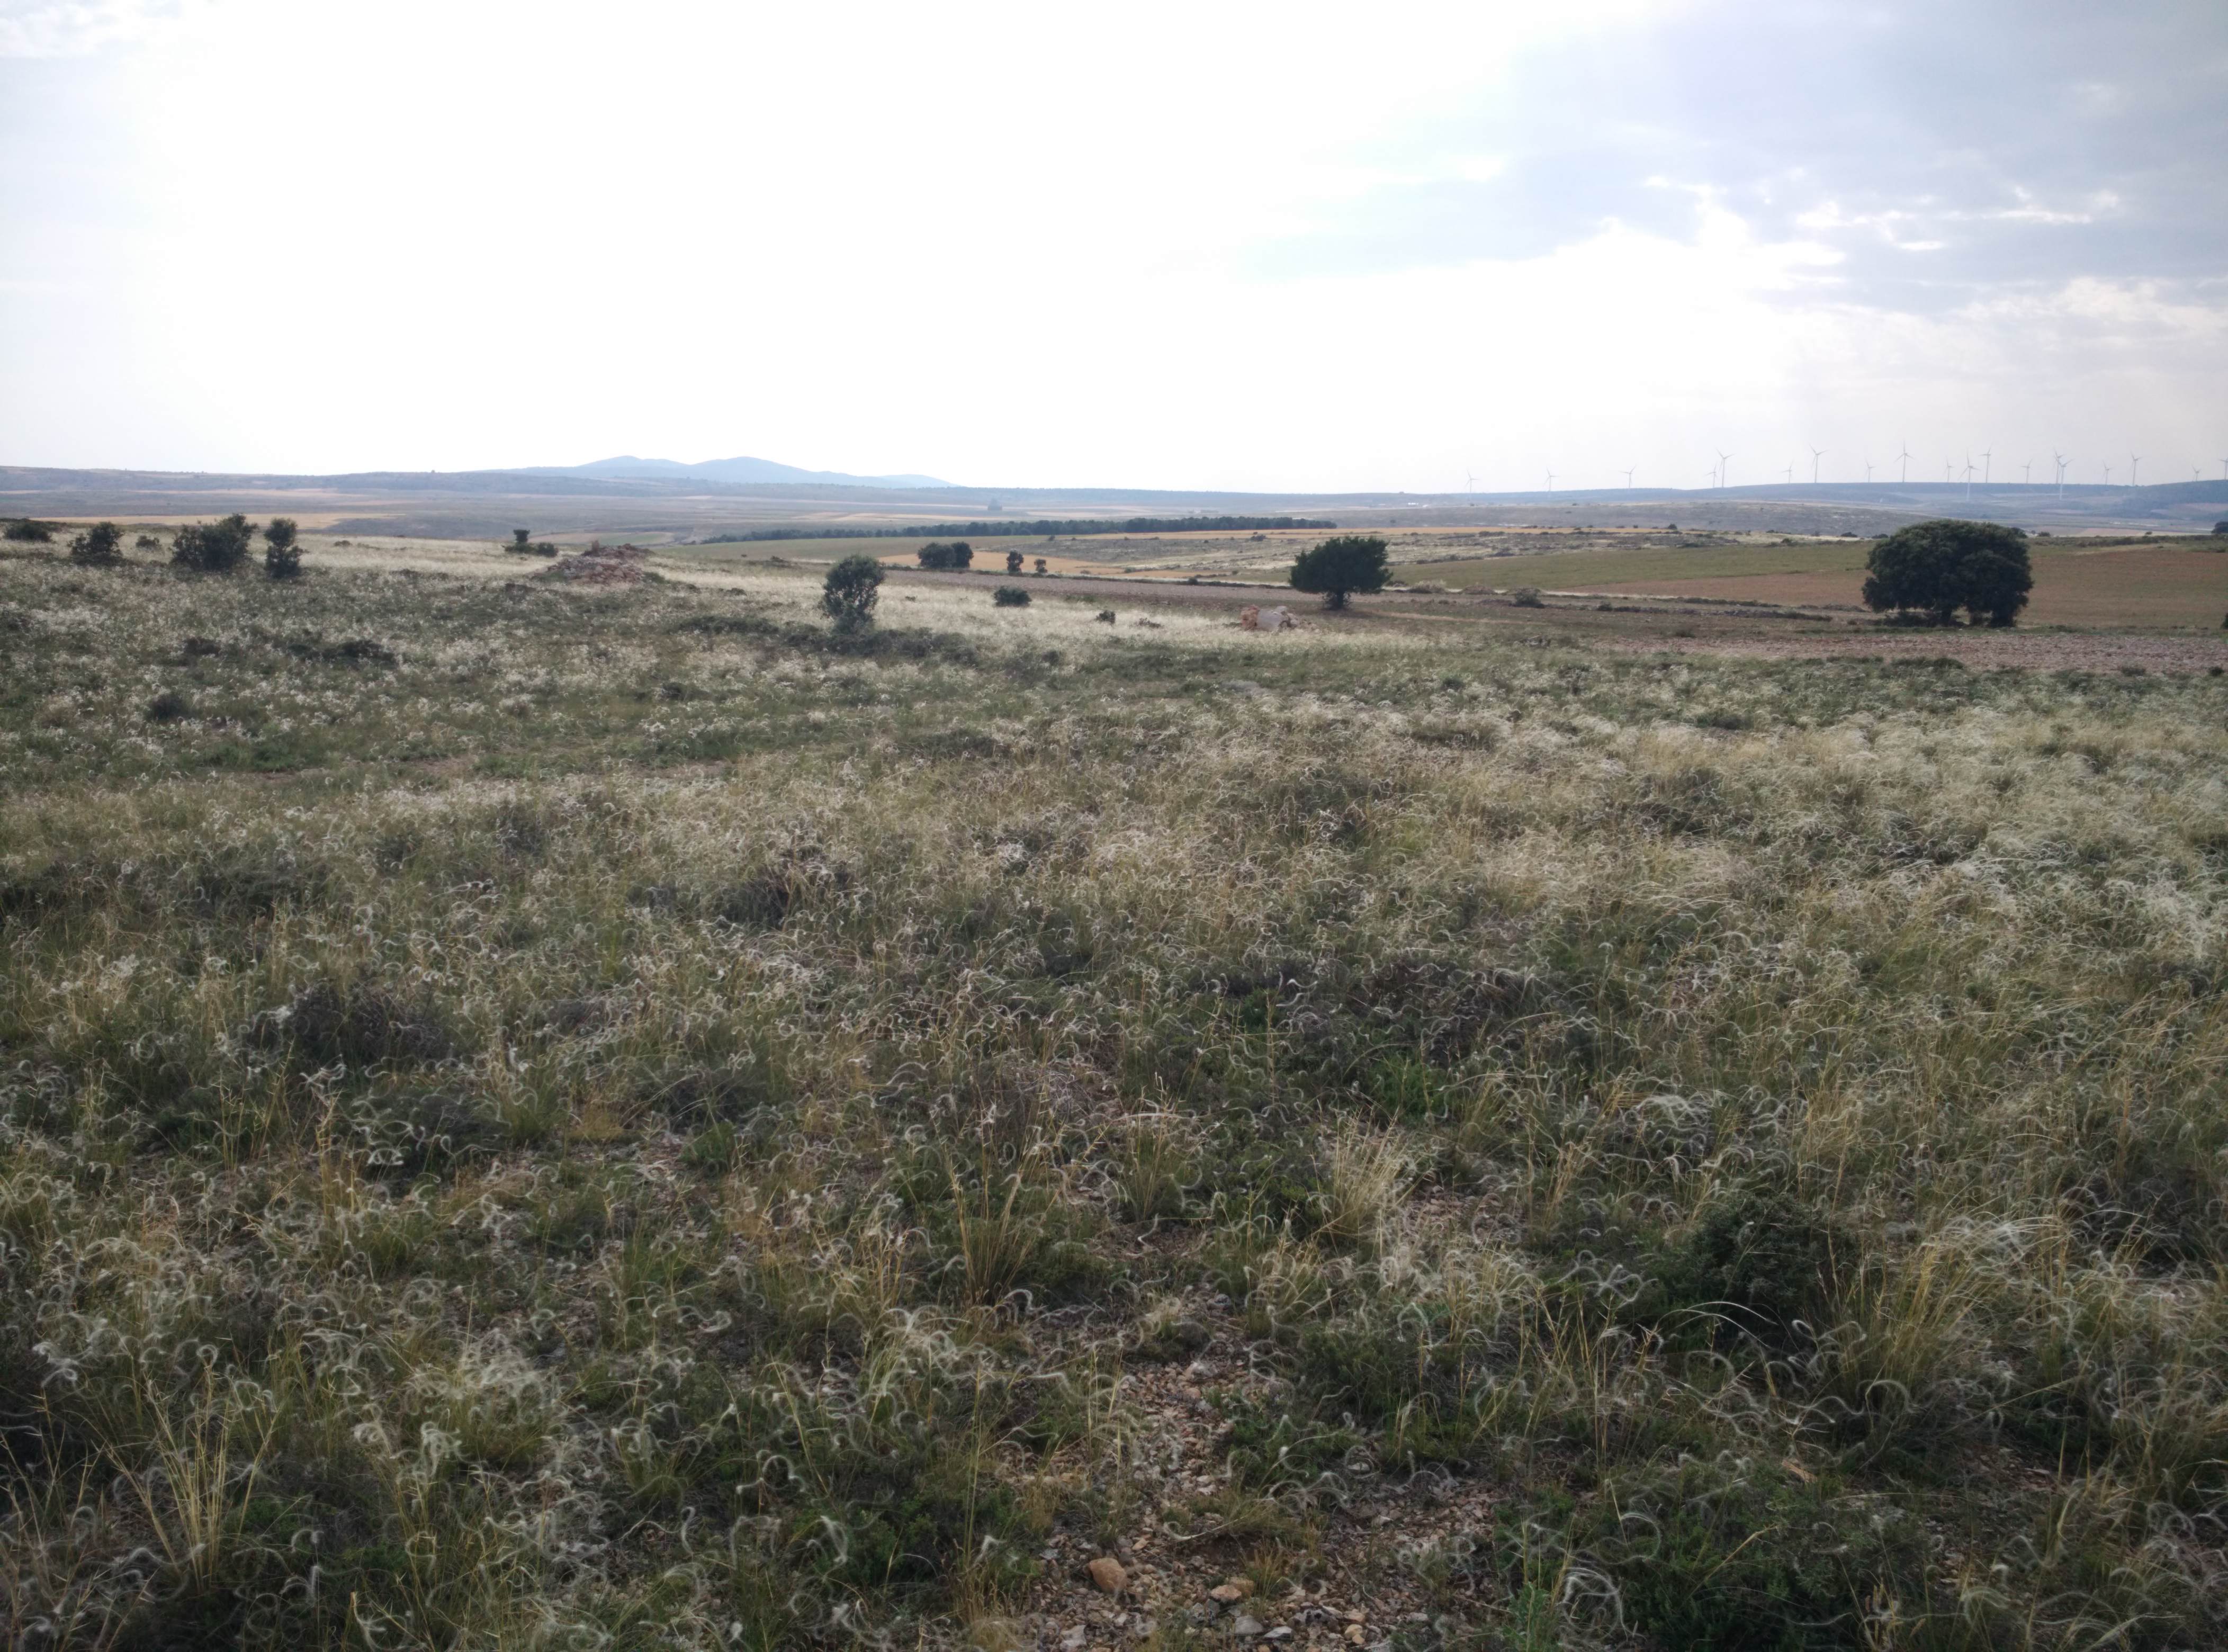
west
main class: Shrubland
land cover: Shrubland without tree cover
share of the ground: 50 - 75 %
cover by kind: shrubs 50 %, unconsolidated bare surface 45 %, herbaceous plants 5 %
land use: Agriculture (excluding fallow land and kitchen gardens)
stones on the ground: 25 - 50 %
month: July
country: ES
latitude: 40.9861
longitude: -1.8739
